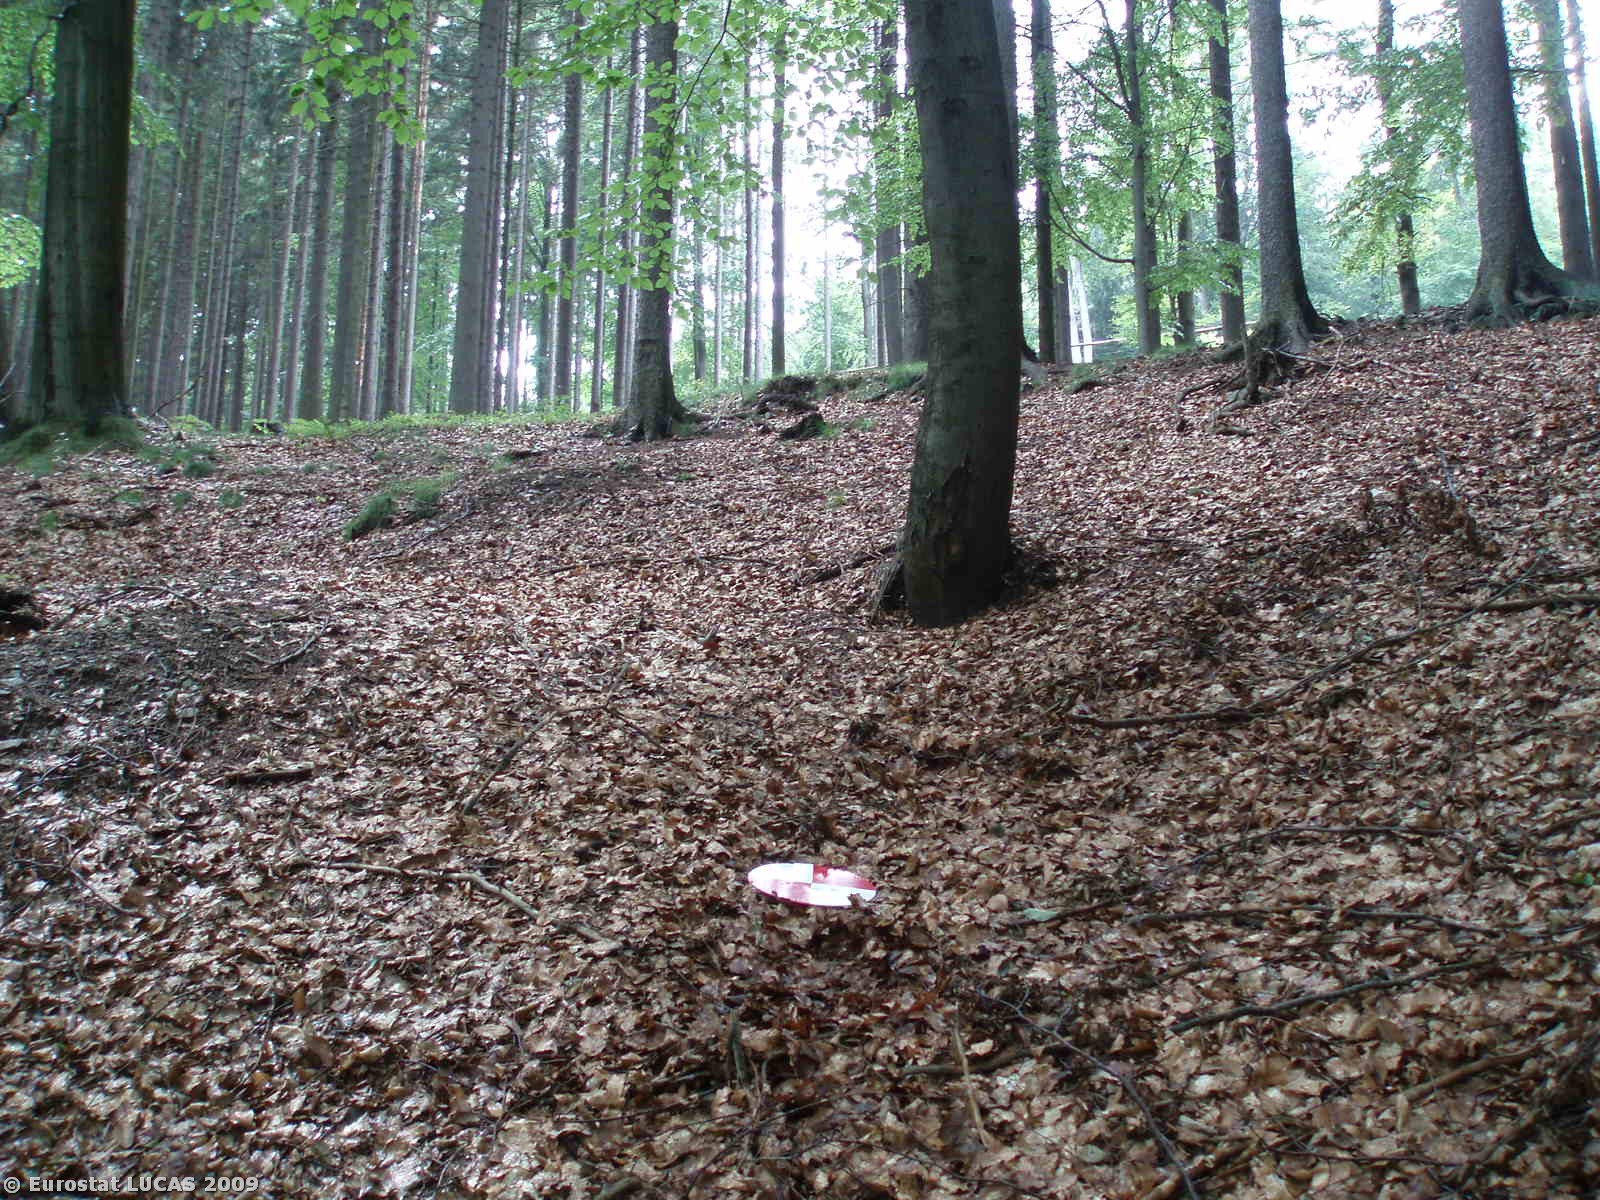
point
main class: Woodland
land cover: Broadleaved woodland
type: beech forest
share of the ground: > 75 %
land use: Forestry
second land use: Nature reserves
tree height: > 5 m
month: July
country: CZ
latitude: 50.8055
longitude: 14.7561
